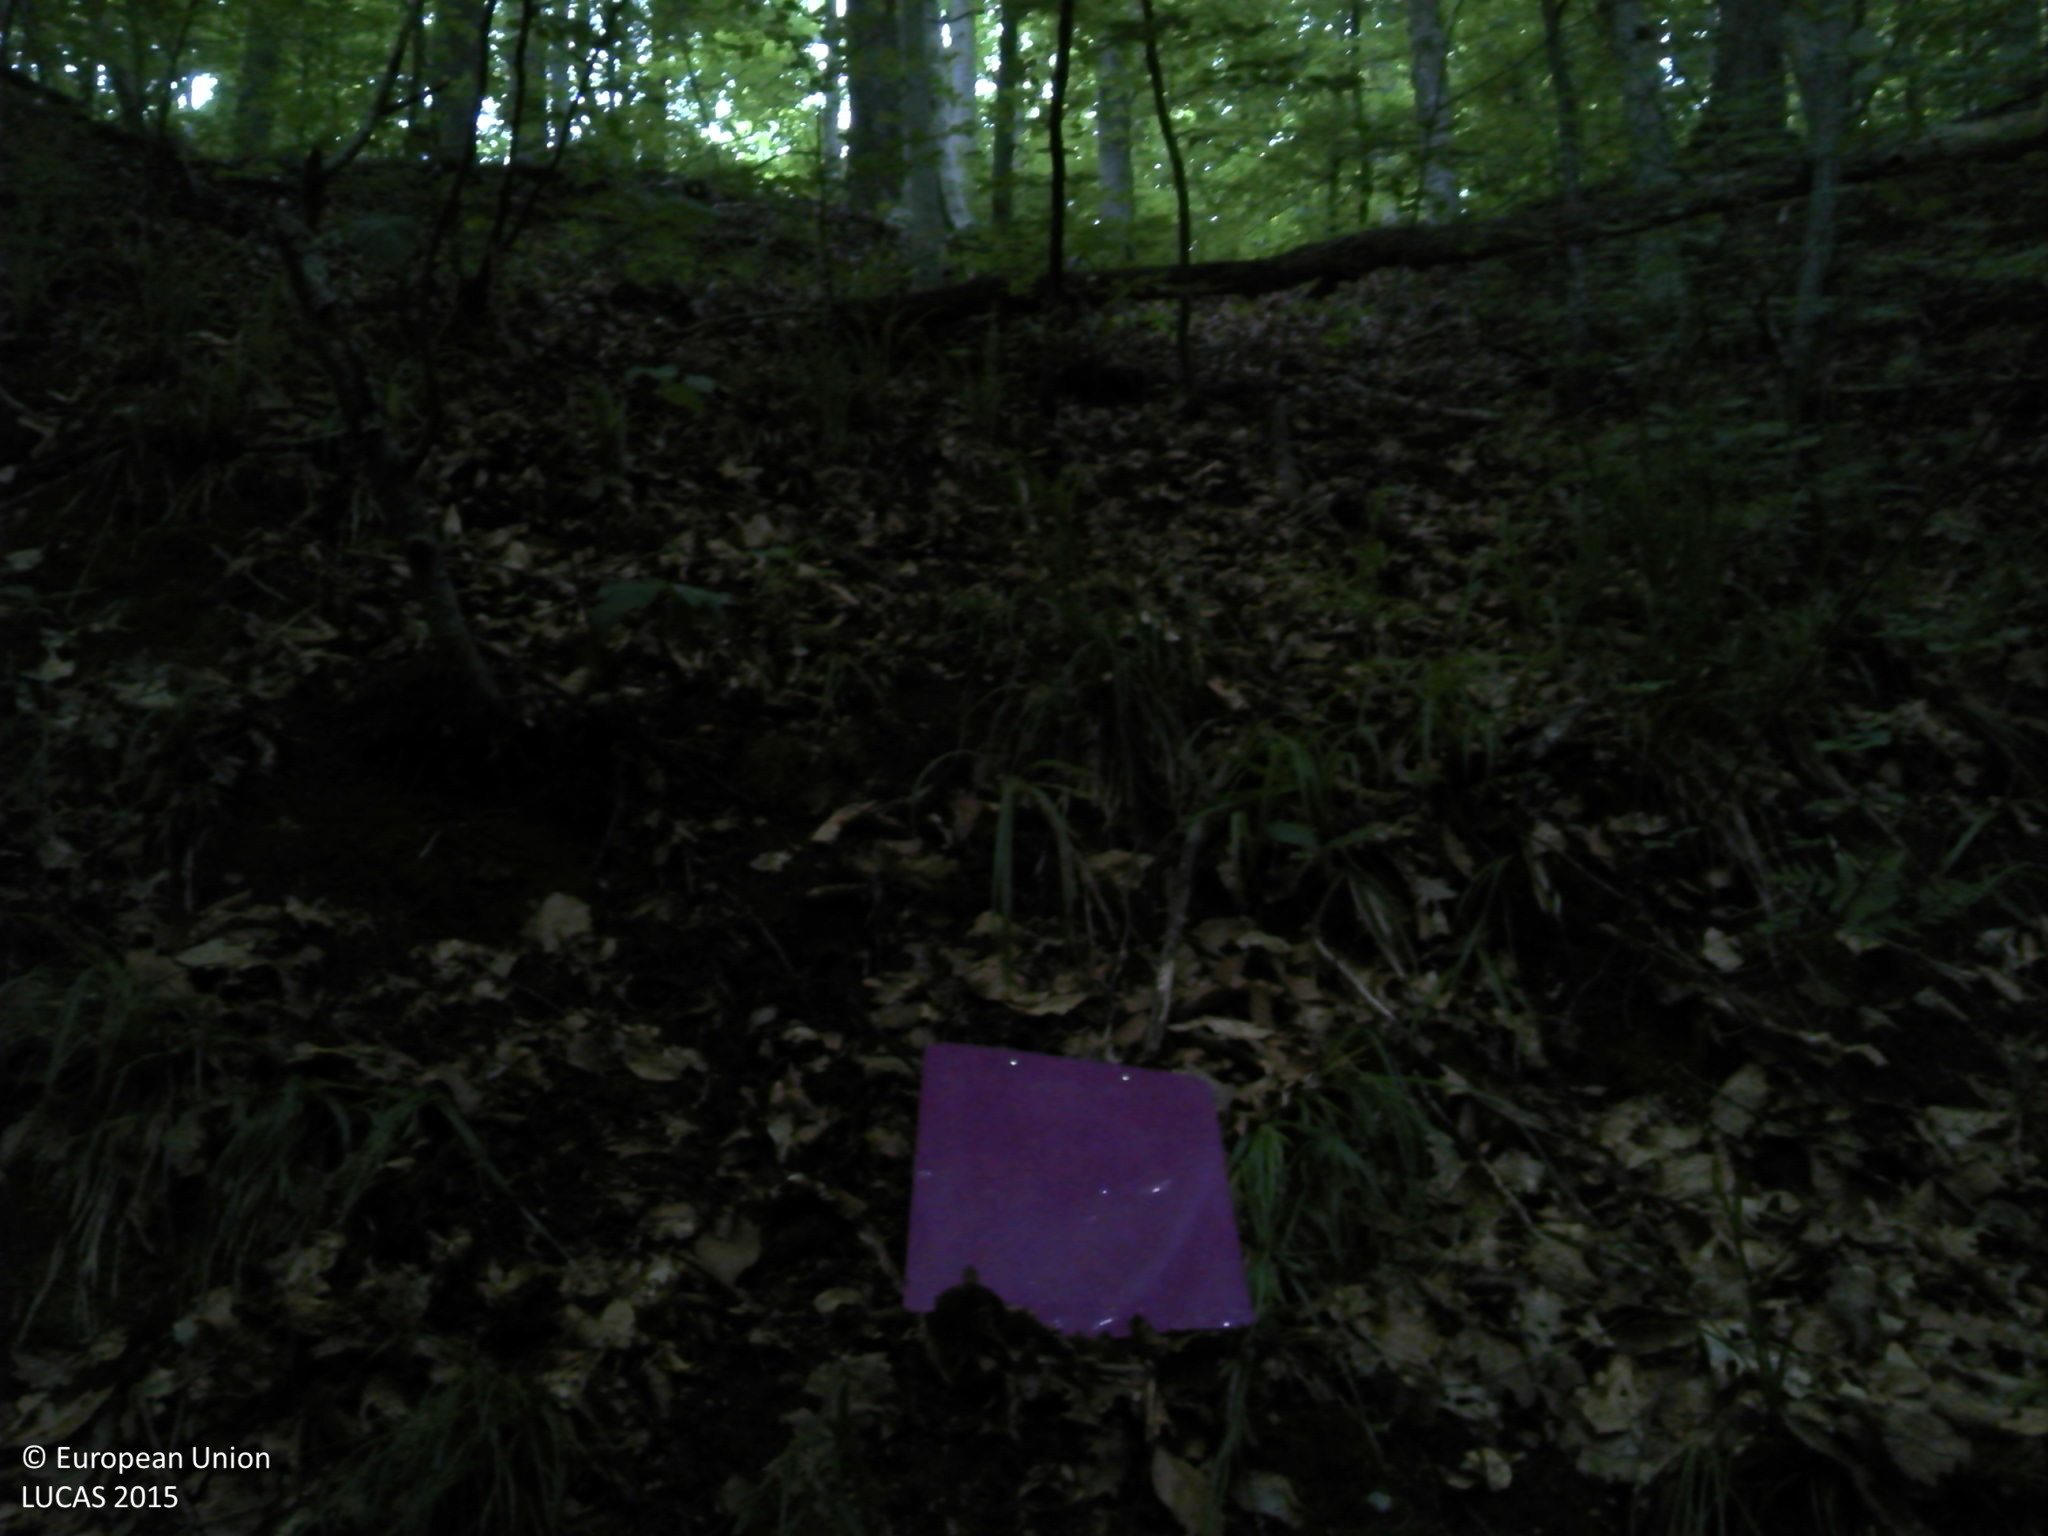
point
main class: Woodland
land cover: Broadleaved woodland
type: acidophilous oak and oak-birch forest
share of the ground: > 75 %
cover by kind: broadleaved forest trees 100 %
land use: Forestry
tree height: > 5 m
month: June
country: HR
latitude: 45.5257
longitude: 17.5173
